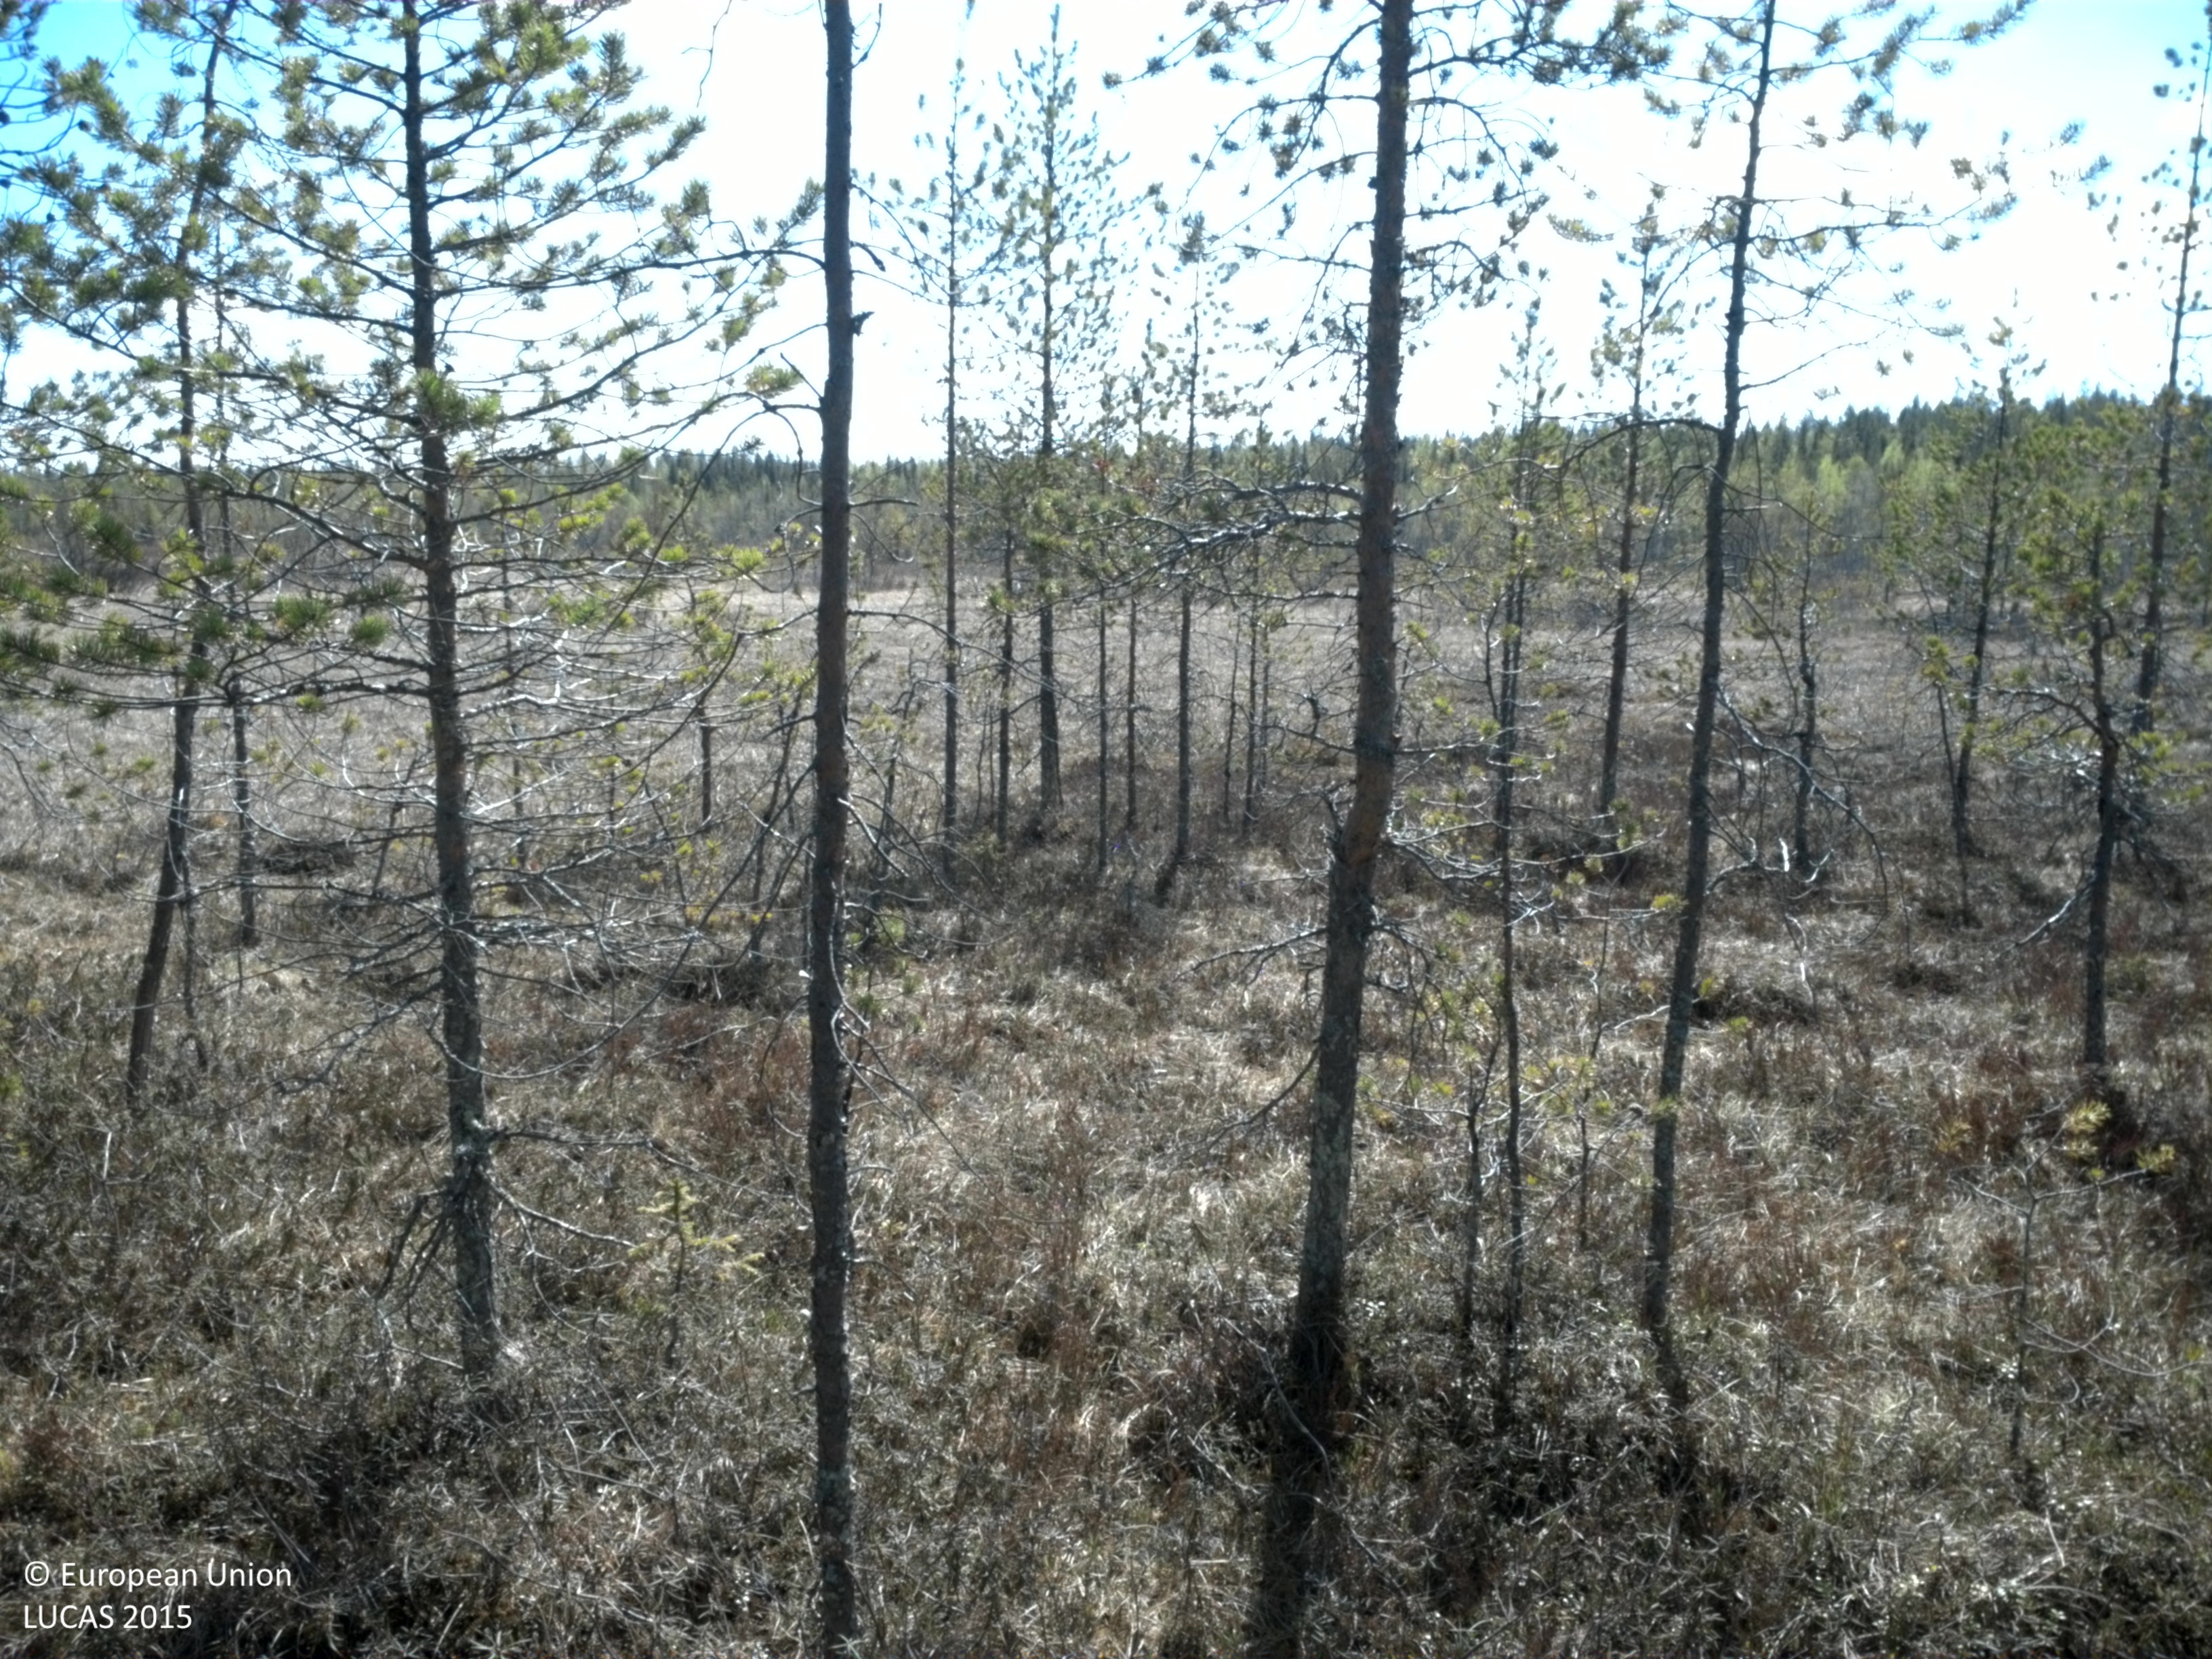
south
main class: Woodland
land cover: Pine dominated coniferous woodland
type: boreal forest
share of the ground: 25 - 50 %
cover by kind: shrubs 55 %, coniferous forest trees 45 %
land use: Forestry
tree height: > 5 m
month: May
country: SE
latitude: 66.1056
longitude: 23.1938
